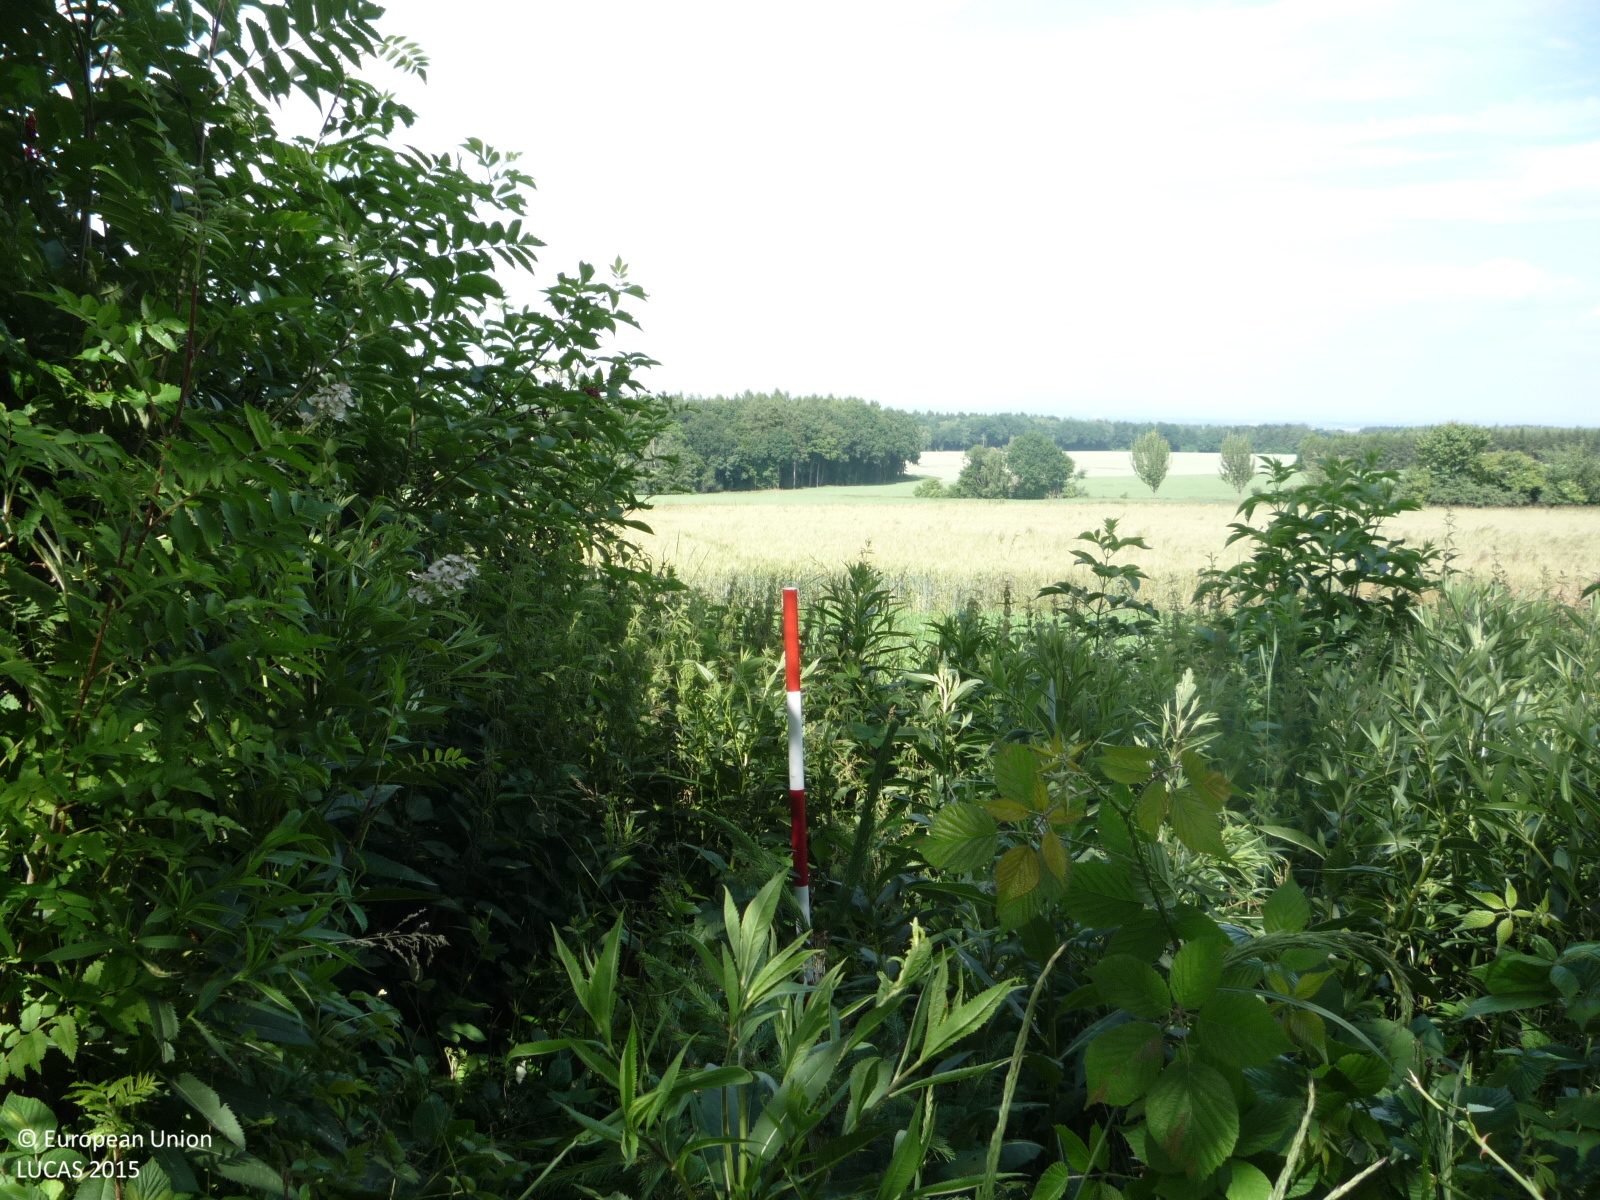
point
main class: Woodland
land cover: Spruce dominated coniferous woodland
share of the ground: 25 - 50 %
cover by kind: coniferous forest trees 40 %, herbaceous plants 40 %, shrubs 20 %
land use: Forestry
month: June
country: CZ
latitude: 49.9389
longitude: 15.5915
